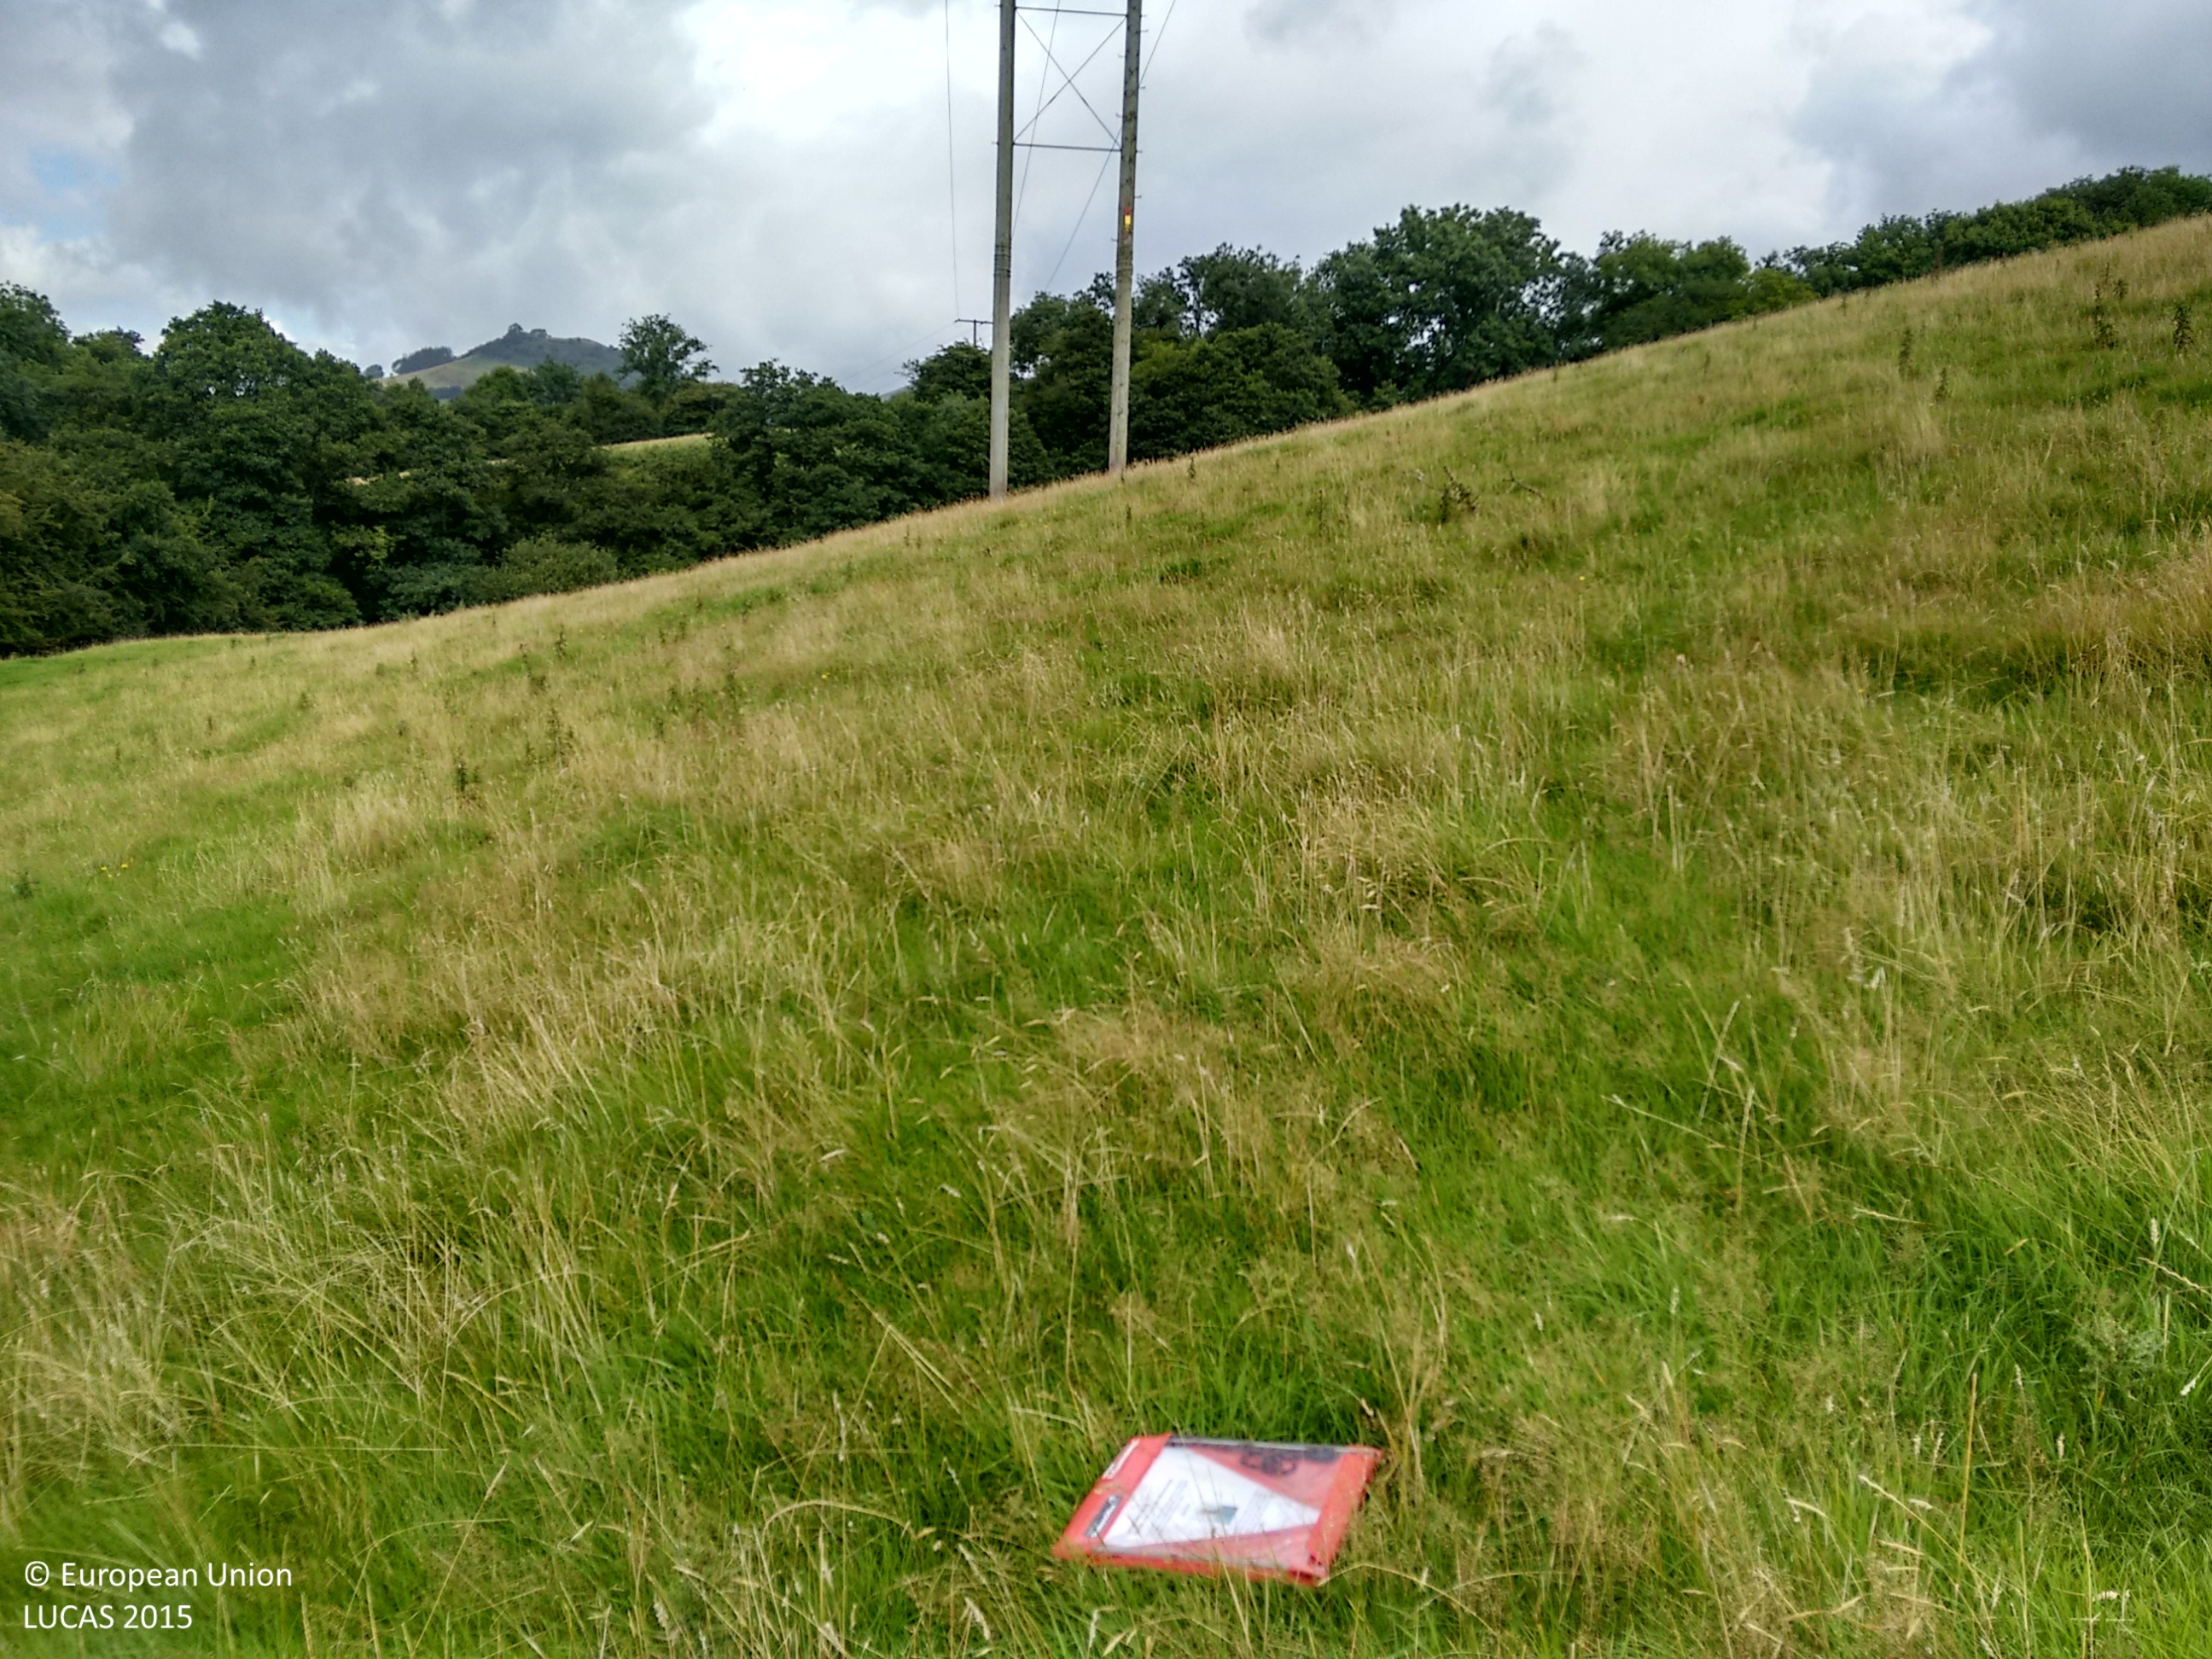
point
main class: Grassland
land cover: Grassland without tree/shrub cover
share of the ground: > 75 %
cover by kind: herbaceous plants 100 %
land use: Agriculture (excluding fallow land and kitchen gardens)
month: September
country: GB
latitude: 51.9475
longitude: -3.1870
